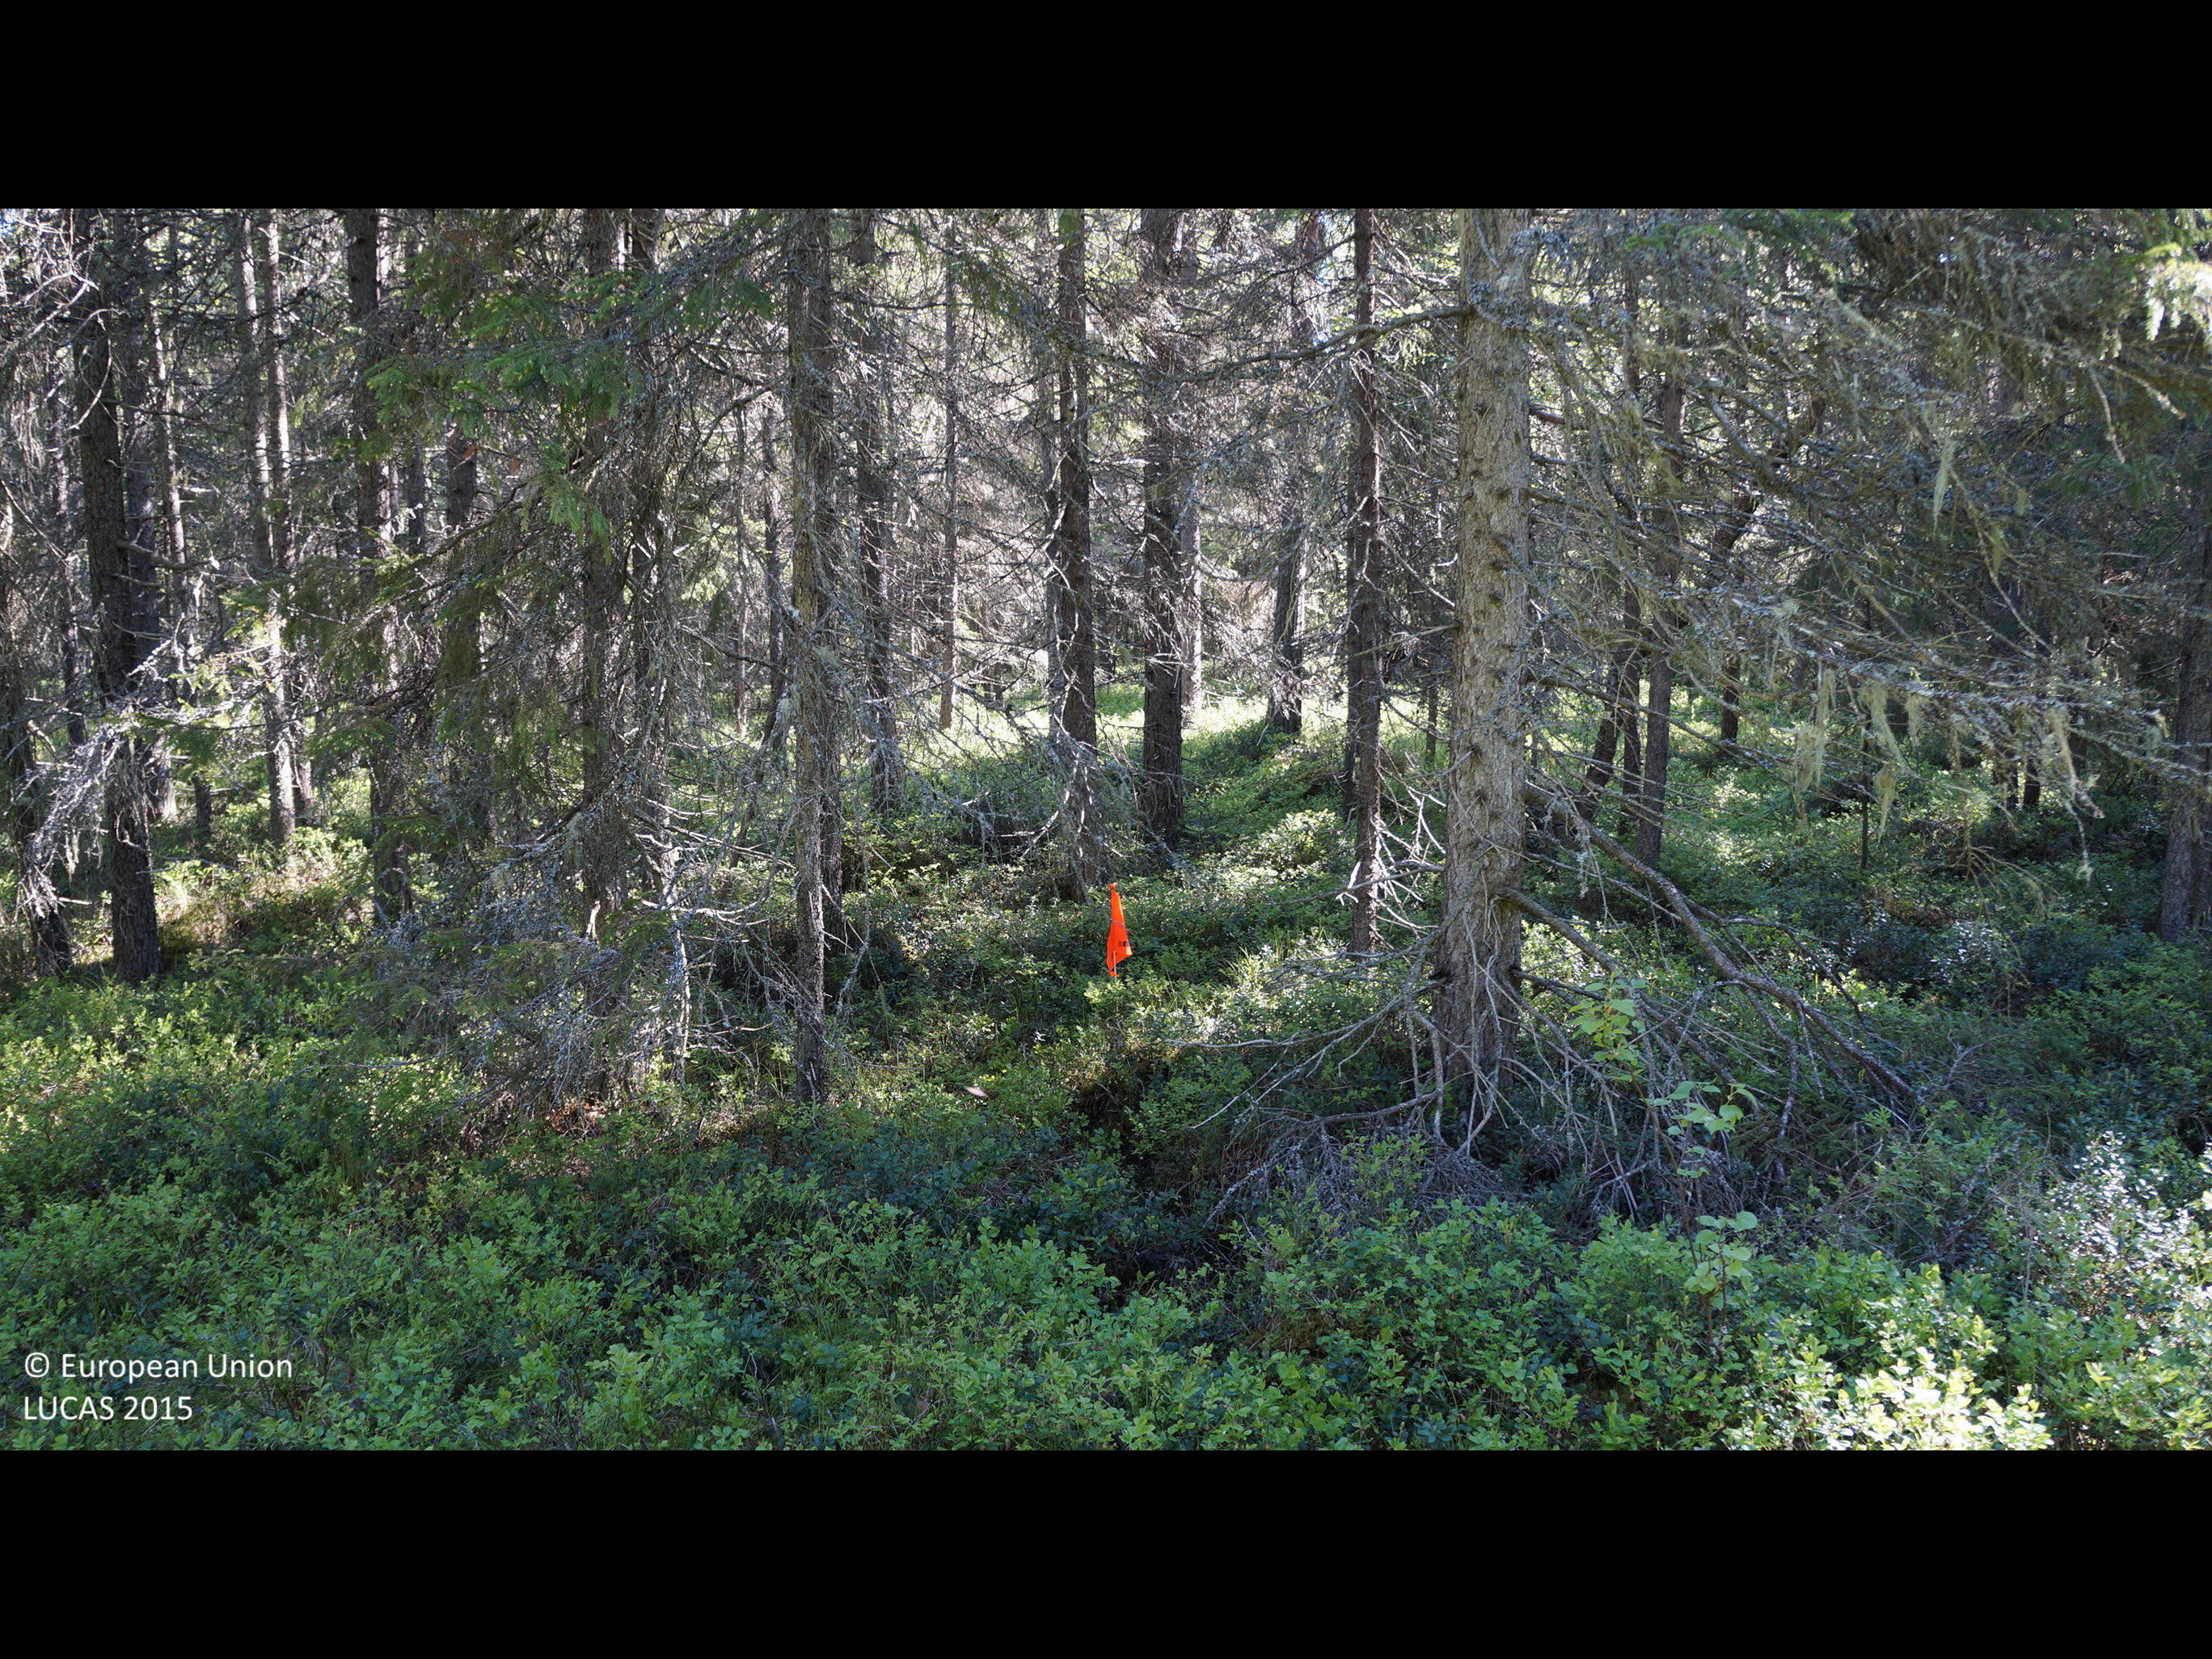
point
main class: Woodland
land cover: Spruce dominated coniferous woodland
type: boreal forest
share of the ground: > 75 %
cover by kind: coniferous forest trees 90 %, shrubs 5 %, herbaceous plants 5 %
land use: Forestry
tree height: > 5 m
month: June
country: FI
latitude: 64.3447
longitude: 23.9935
